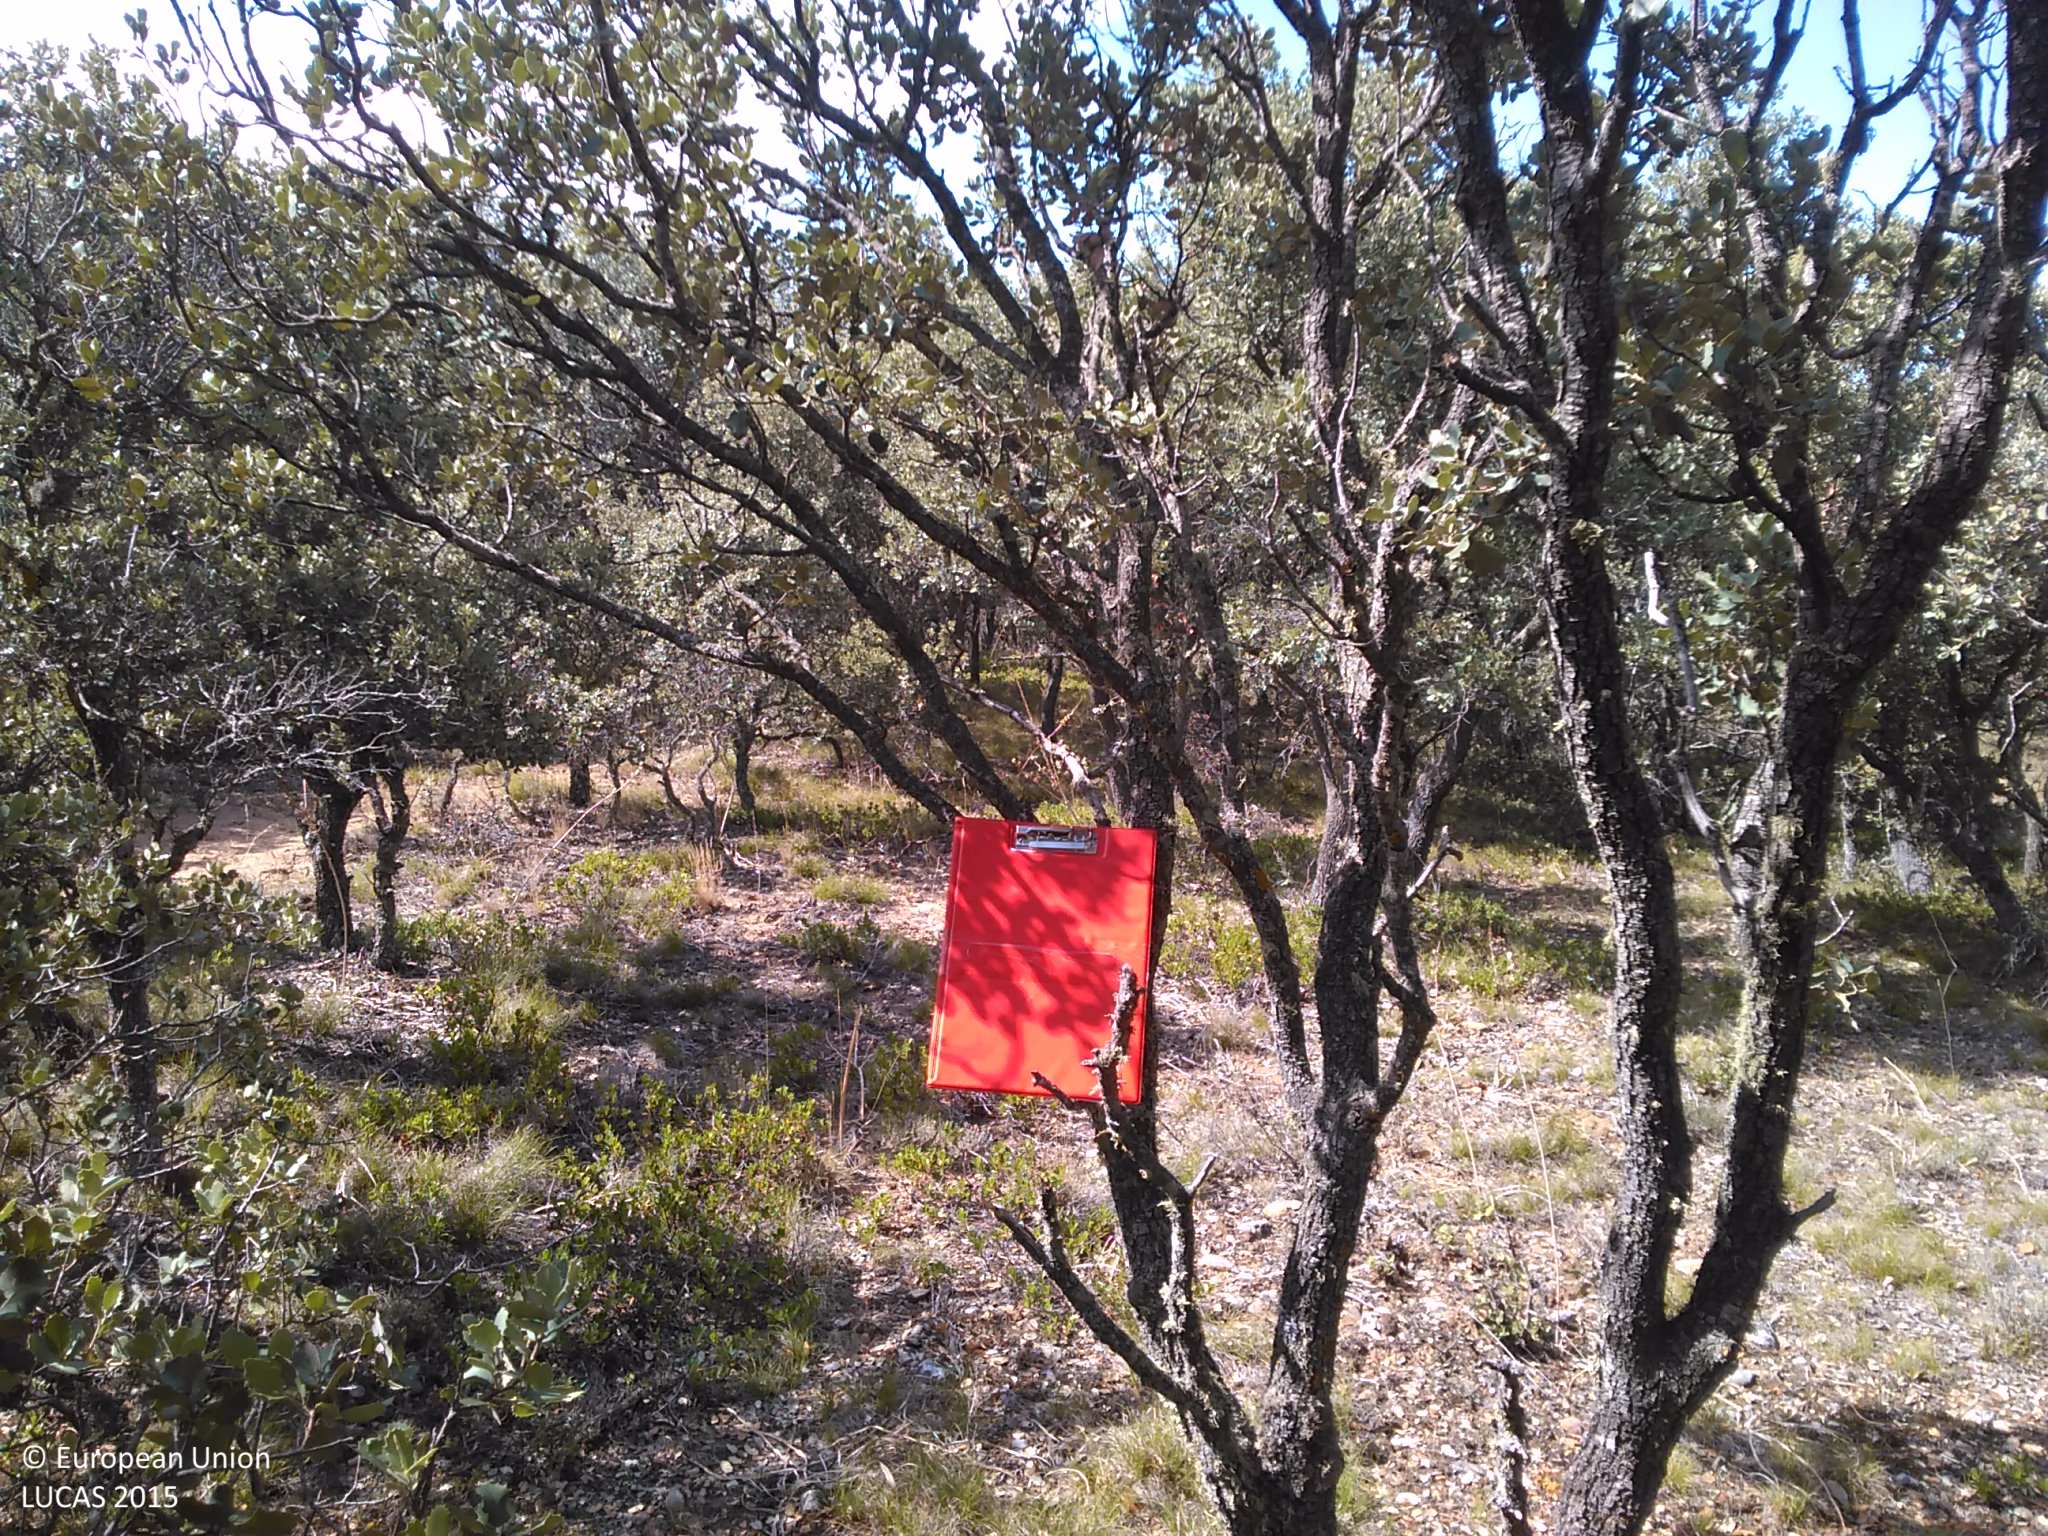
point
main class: Woodland
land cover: Broadleaved woodland
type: thermophilous deciduous forest
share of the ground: 50 - 75 %
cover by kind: broadleaved forest trees 60 %, unconsolidated bare surface 15 %, shrubs 10 %, herbaceous plants 10 %, lichens and mosses 5 %
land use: Semi-natural and natural areas not in use
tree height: < 5 m
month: July
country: ES
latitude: 41.5307
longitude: -2.1975
